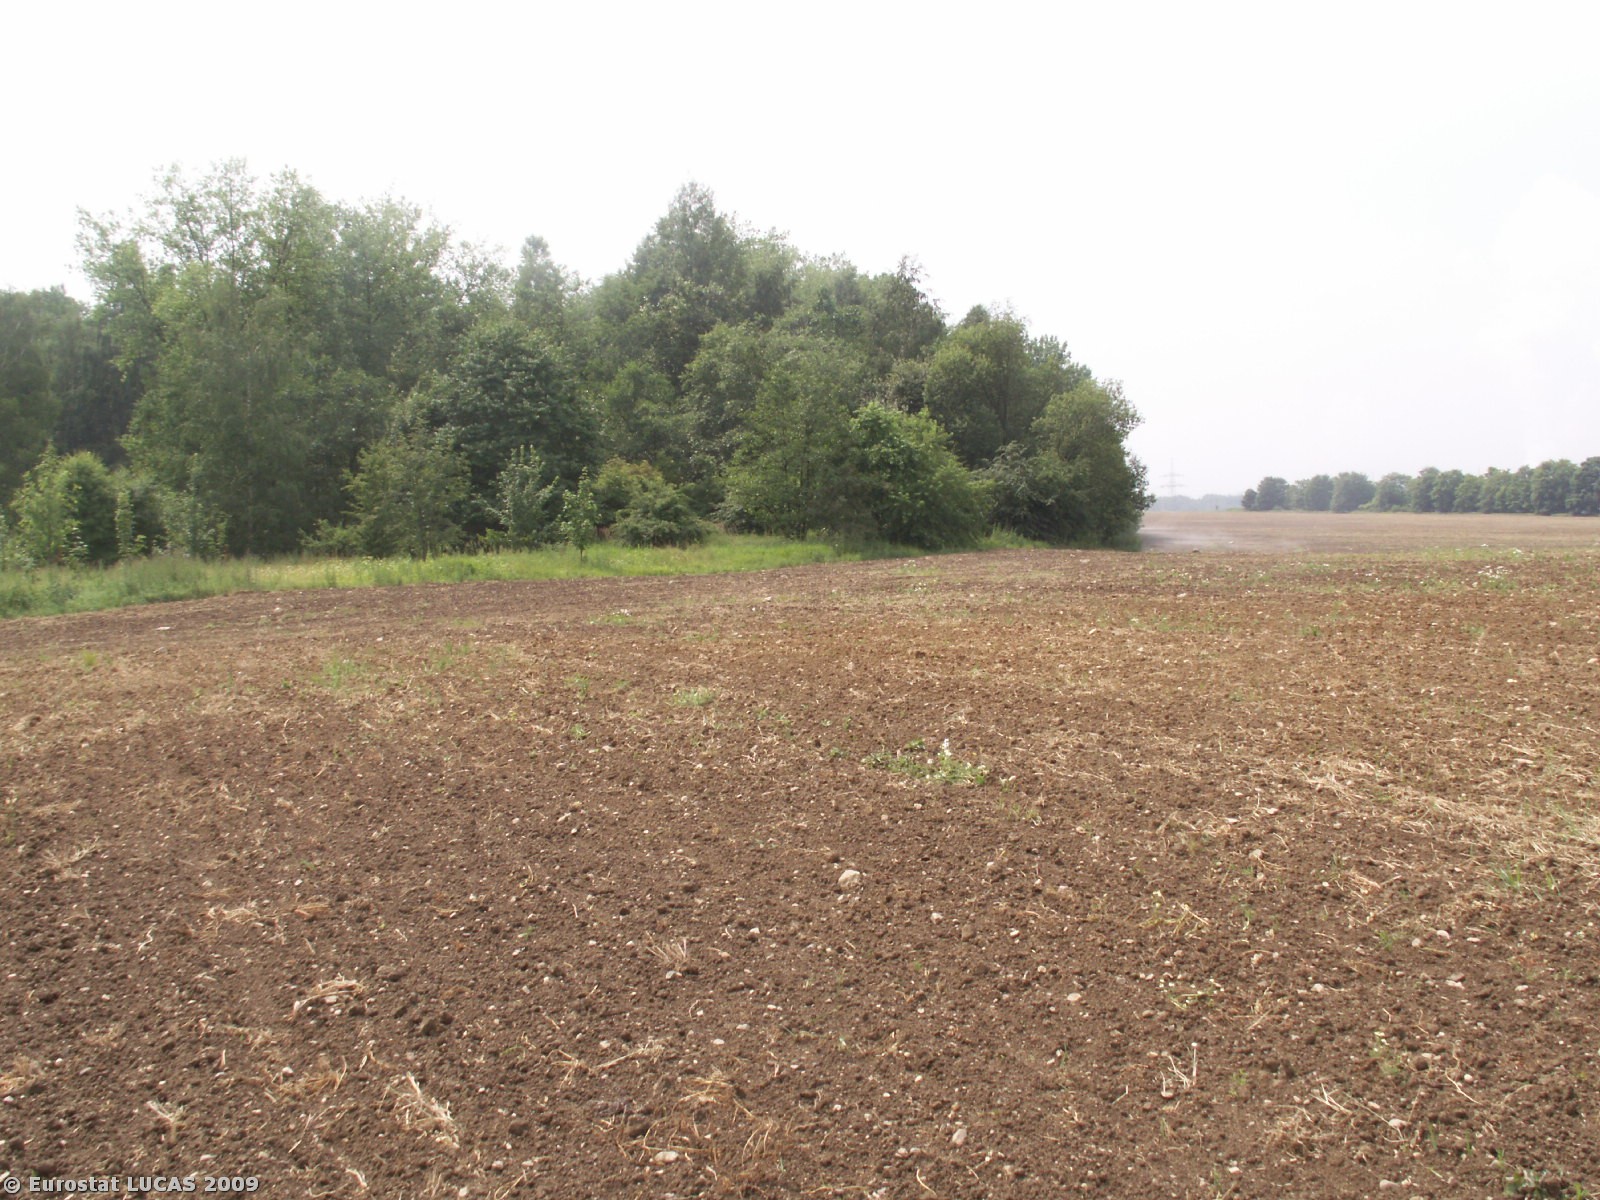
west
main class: Cropland
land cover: Other fibre and oleaginous crops
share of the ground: < 10 %
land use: Agriculture (excluding fallow land and kitchen gardens)
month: June
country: CZ
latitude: 50.2415
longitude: 12.7340
